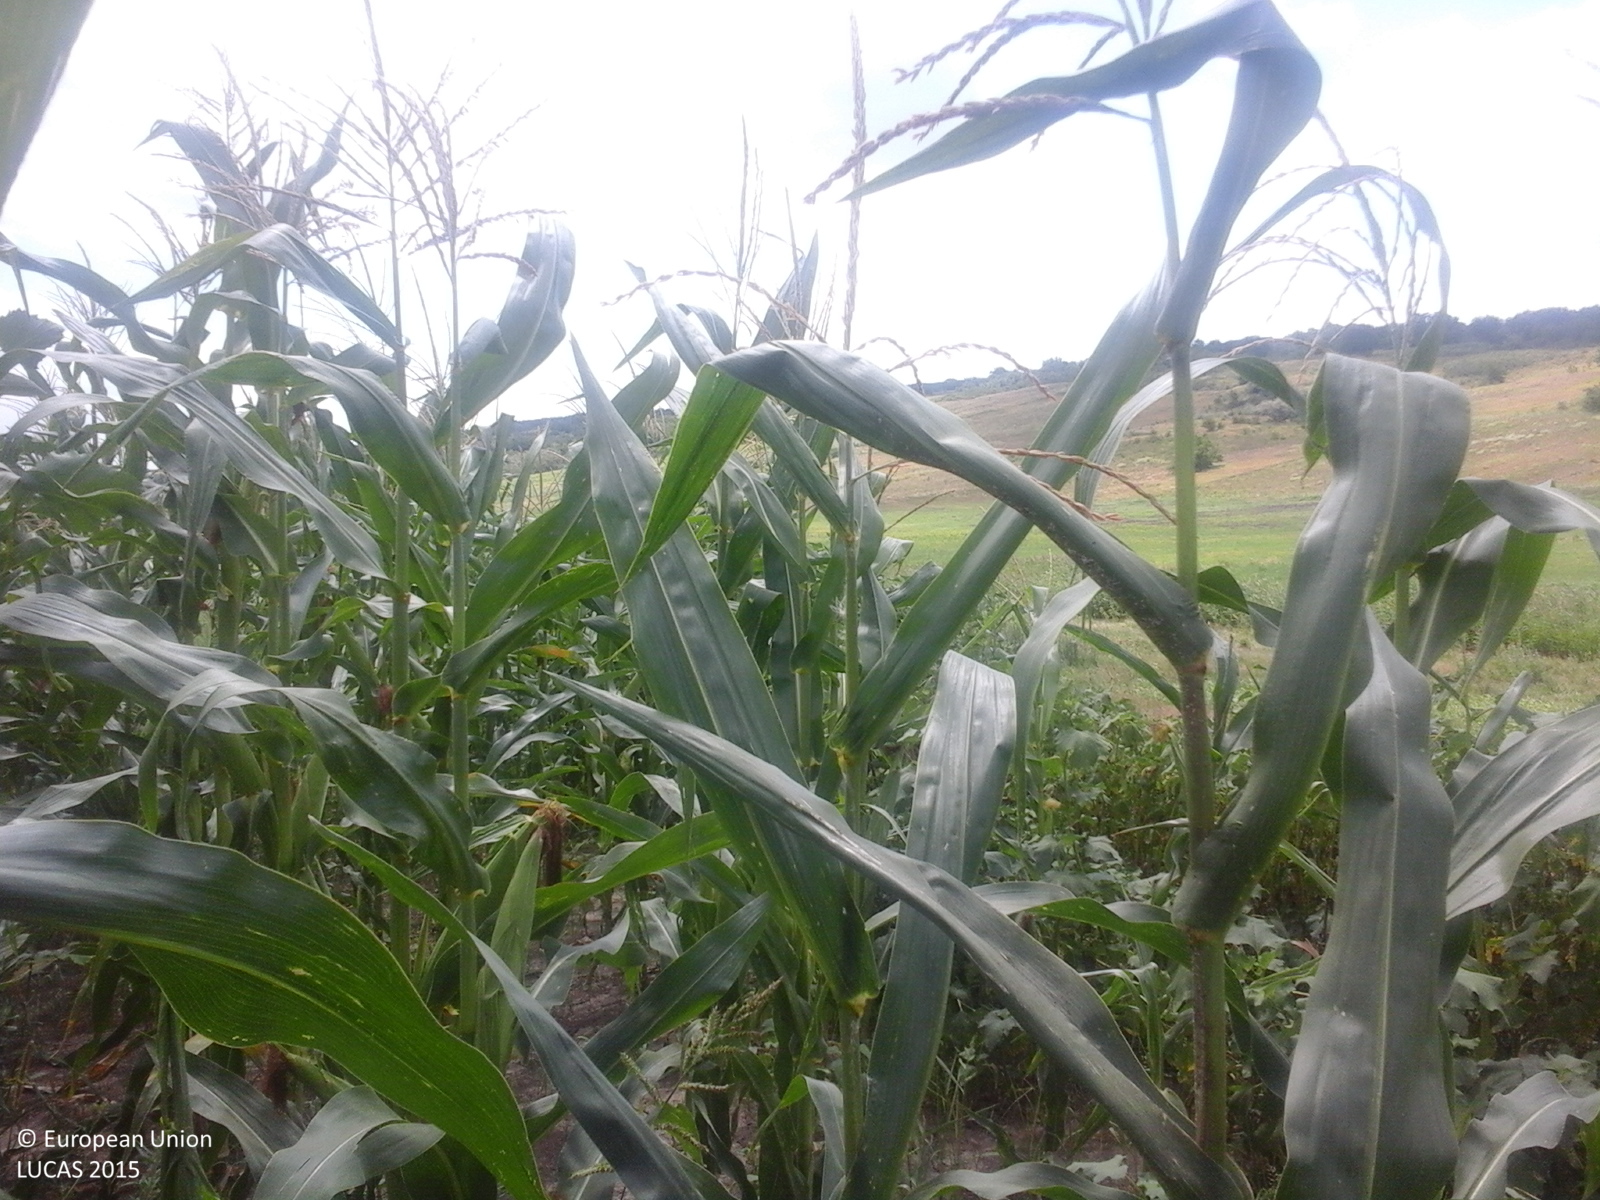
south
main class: Cropland
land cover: Maize
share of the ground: > 75 %
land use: Agriculture (excluding fallow land and kitchen gardens)
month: July
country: RO
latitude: 46.5227
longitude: 27.9985
